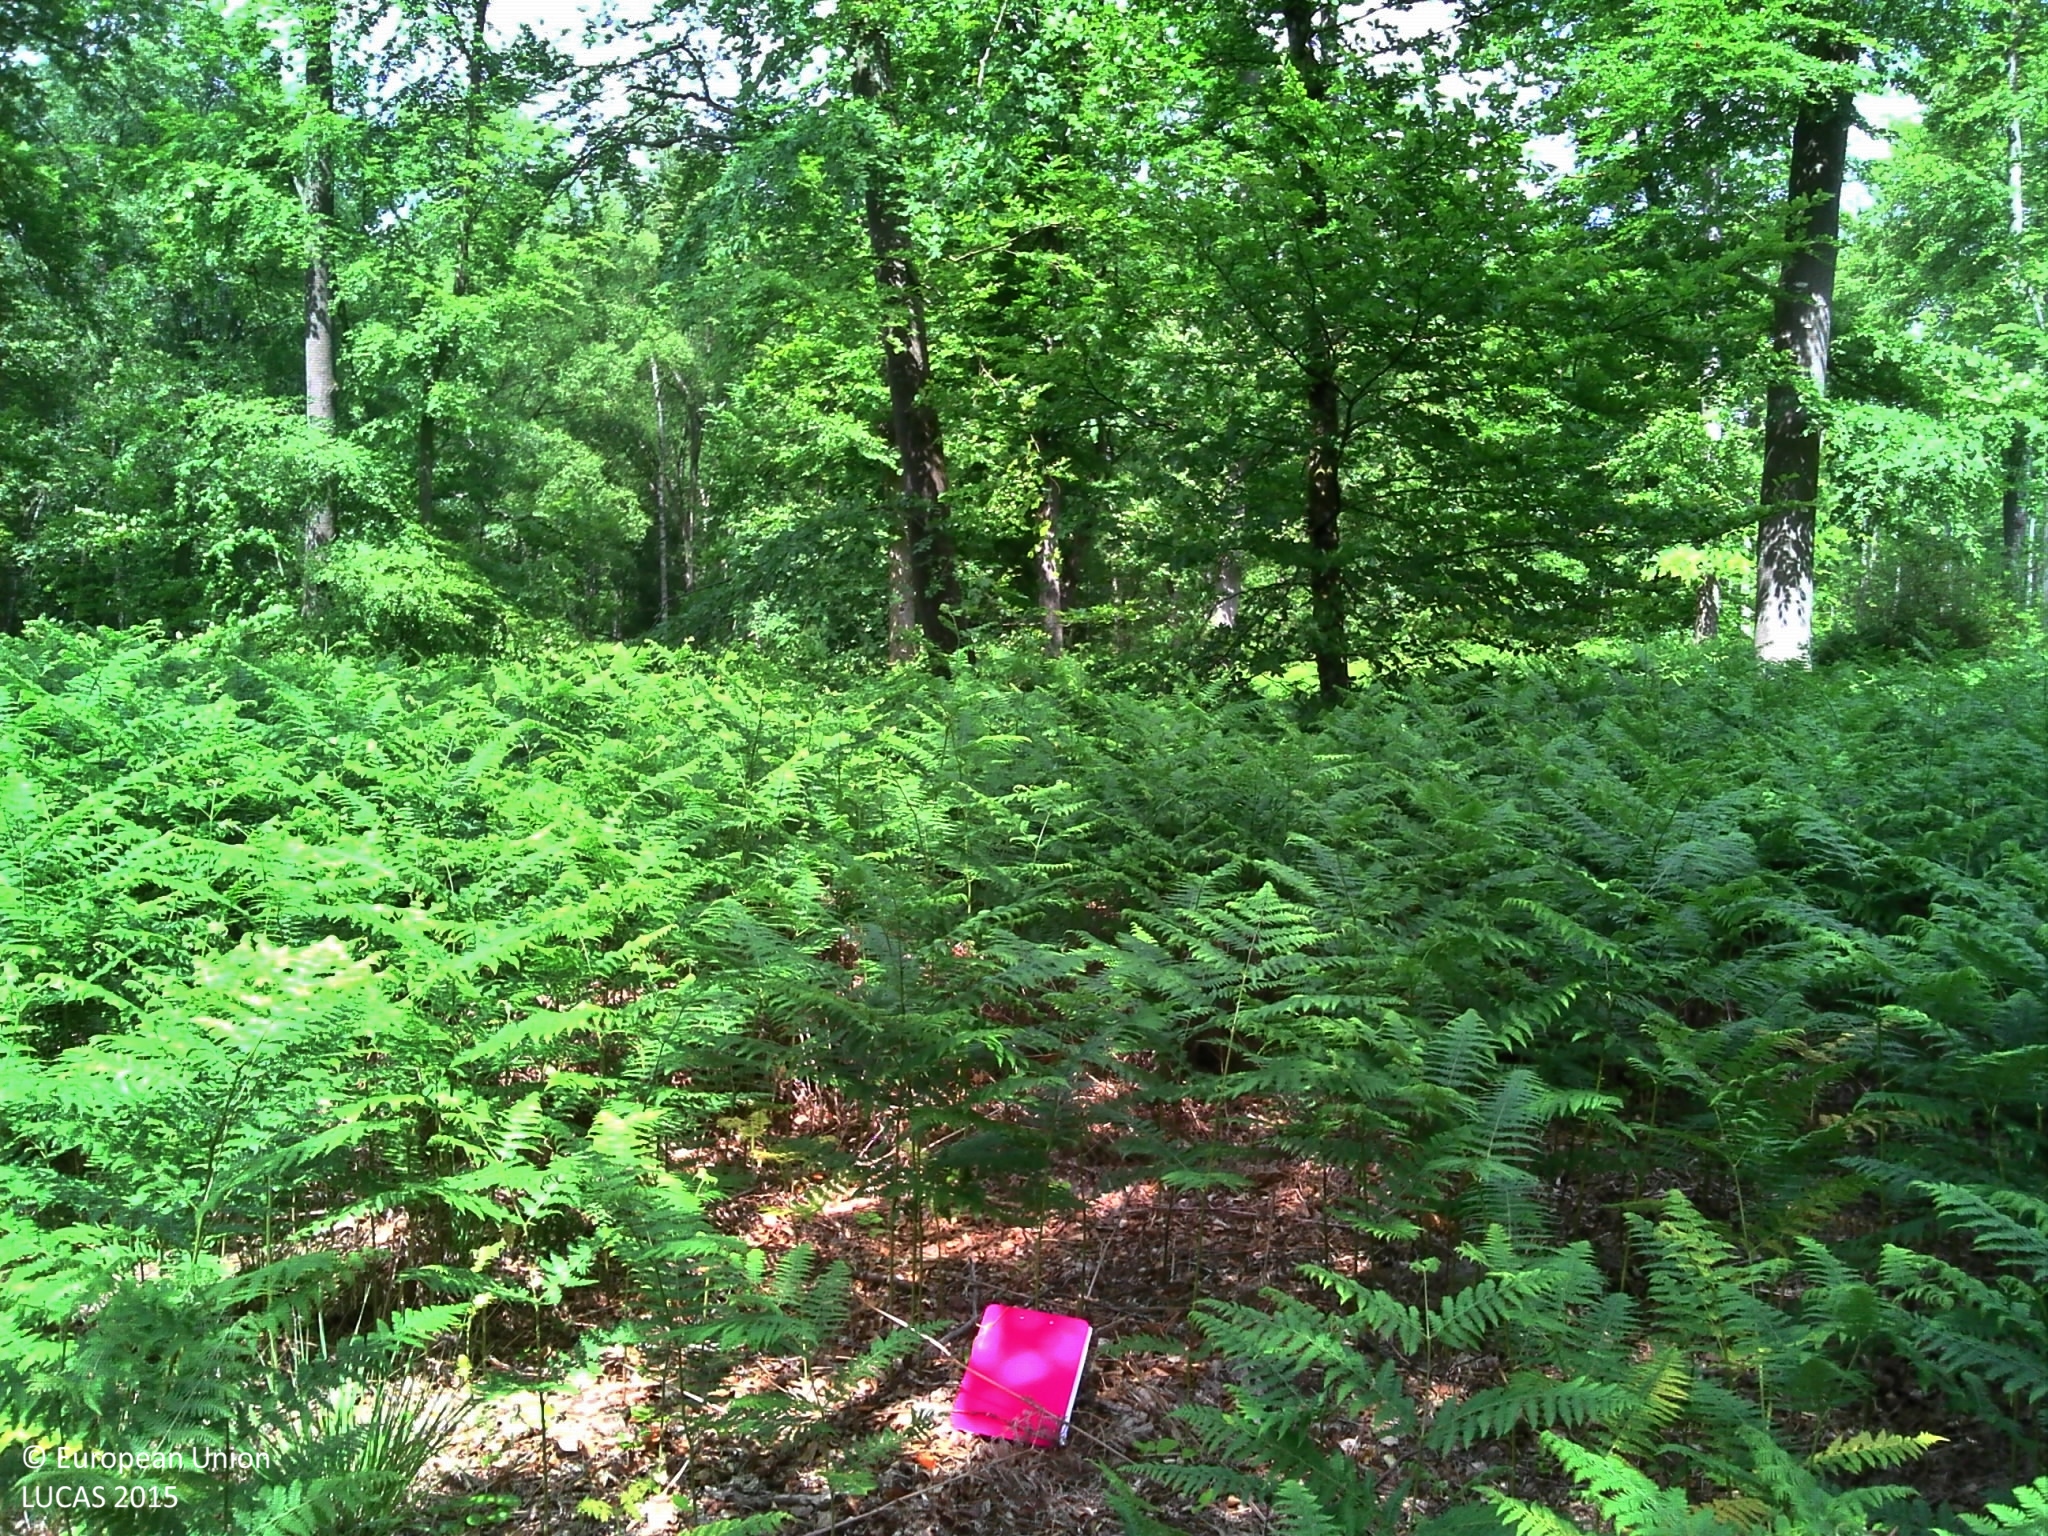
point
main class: Woodland
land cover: Broadleaved woodland
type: beech forest
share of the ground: > 75 %
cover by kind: broadleaved forest trees 75 %, shrubs 15 %, herbaceous plants 5 %, unconsolidated bare surface 5 %
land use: Forestry
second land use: Amenities, museums, leisure
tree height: > 5 m
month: June
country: FR
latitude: 49.3508
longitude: 2.9284
